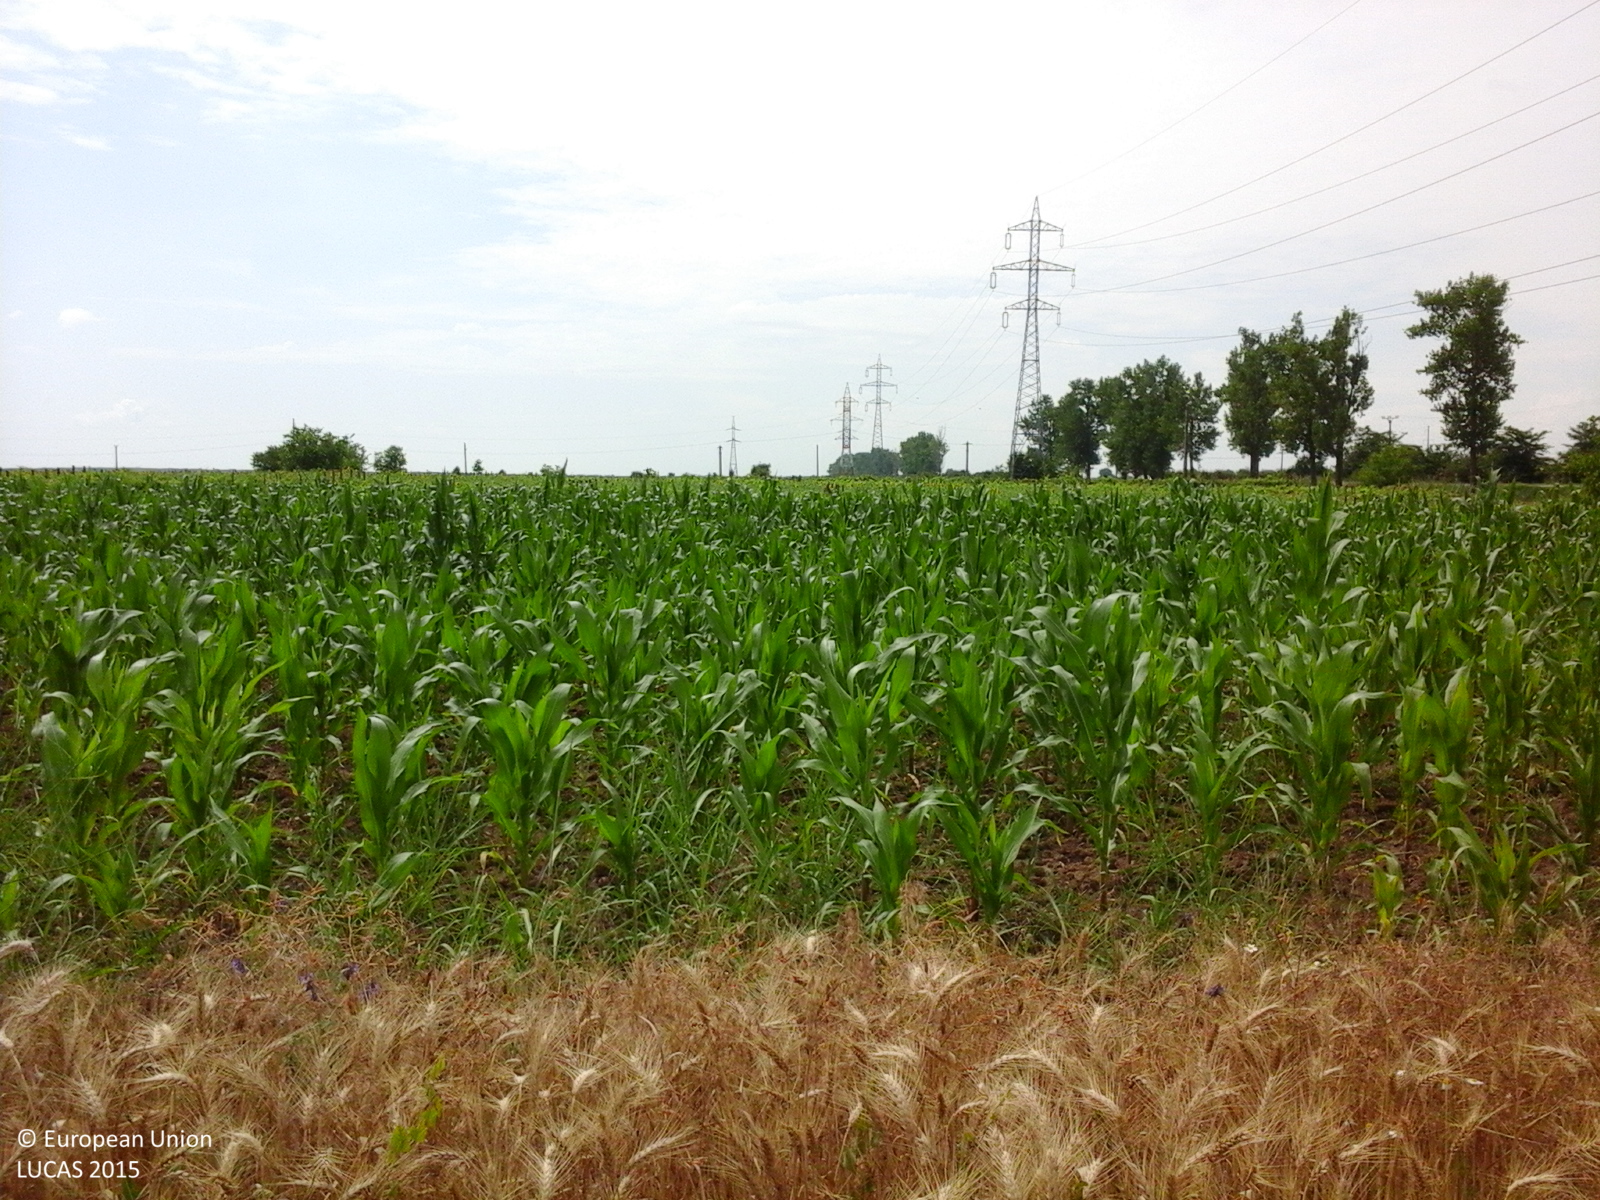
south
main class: Cropland
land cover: Common wheat
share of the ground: > 75 %
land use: Agriculture (excluding fallow land and kitchen gardens)
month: June
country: RO
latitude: 44.1595
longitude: 26.3772
